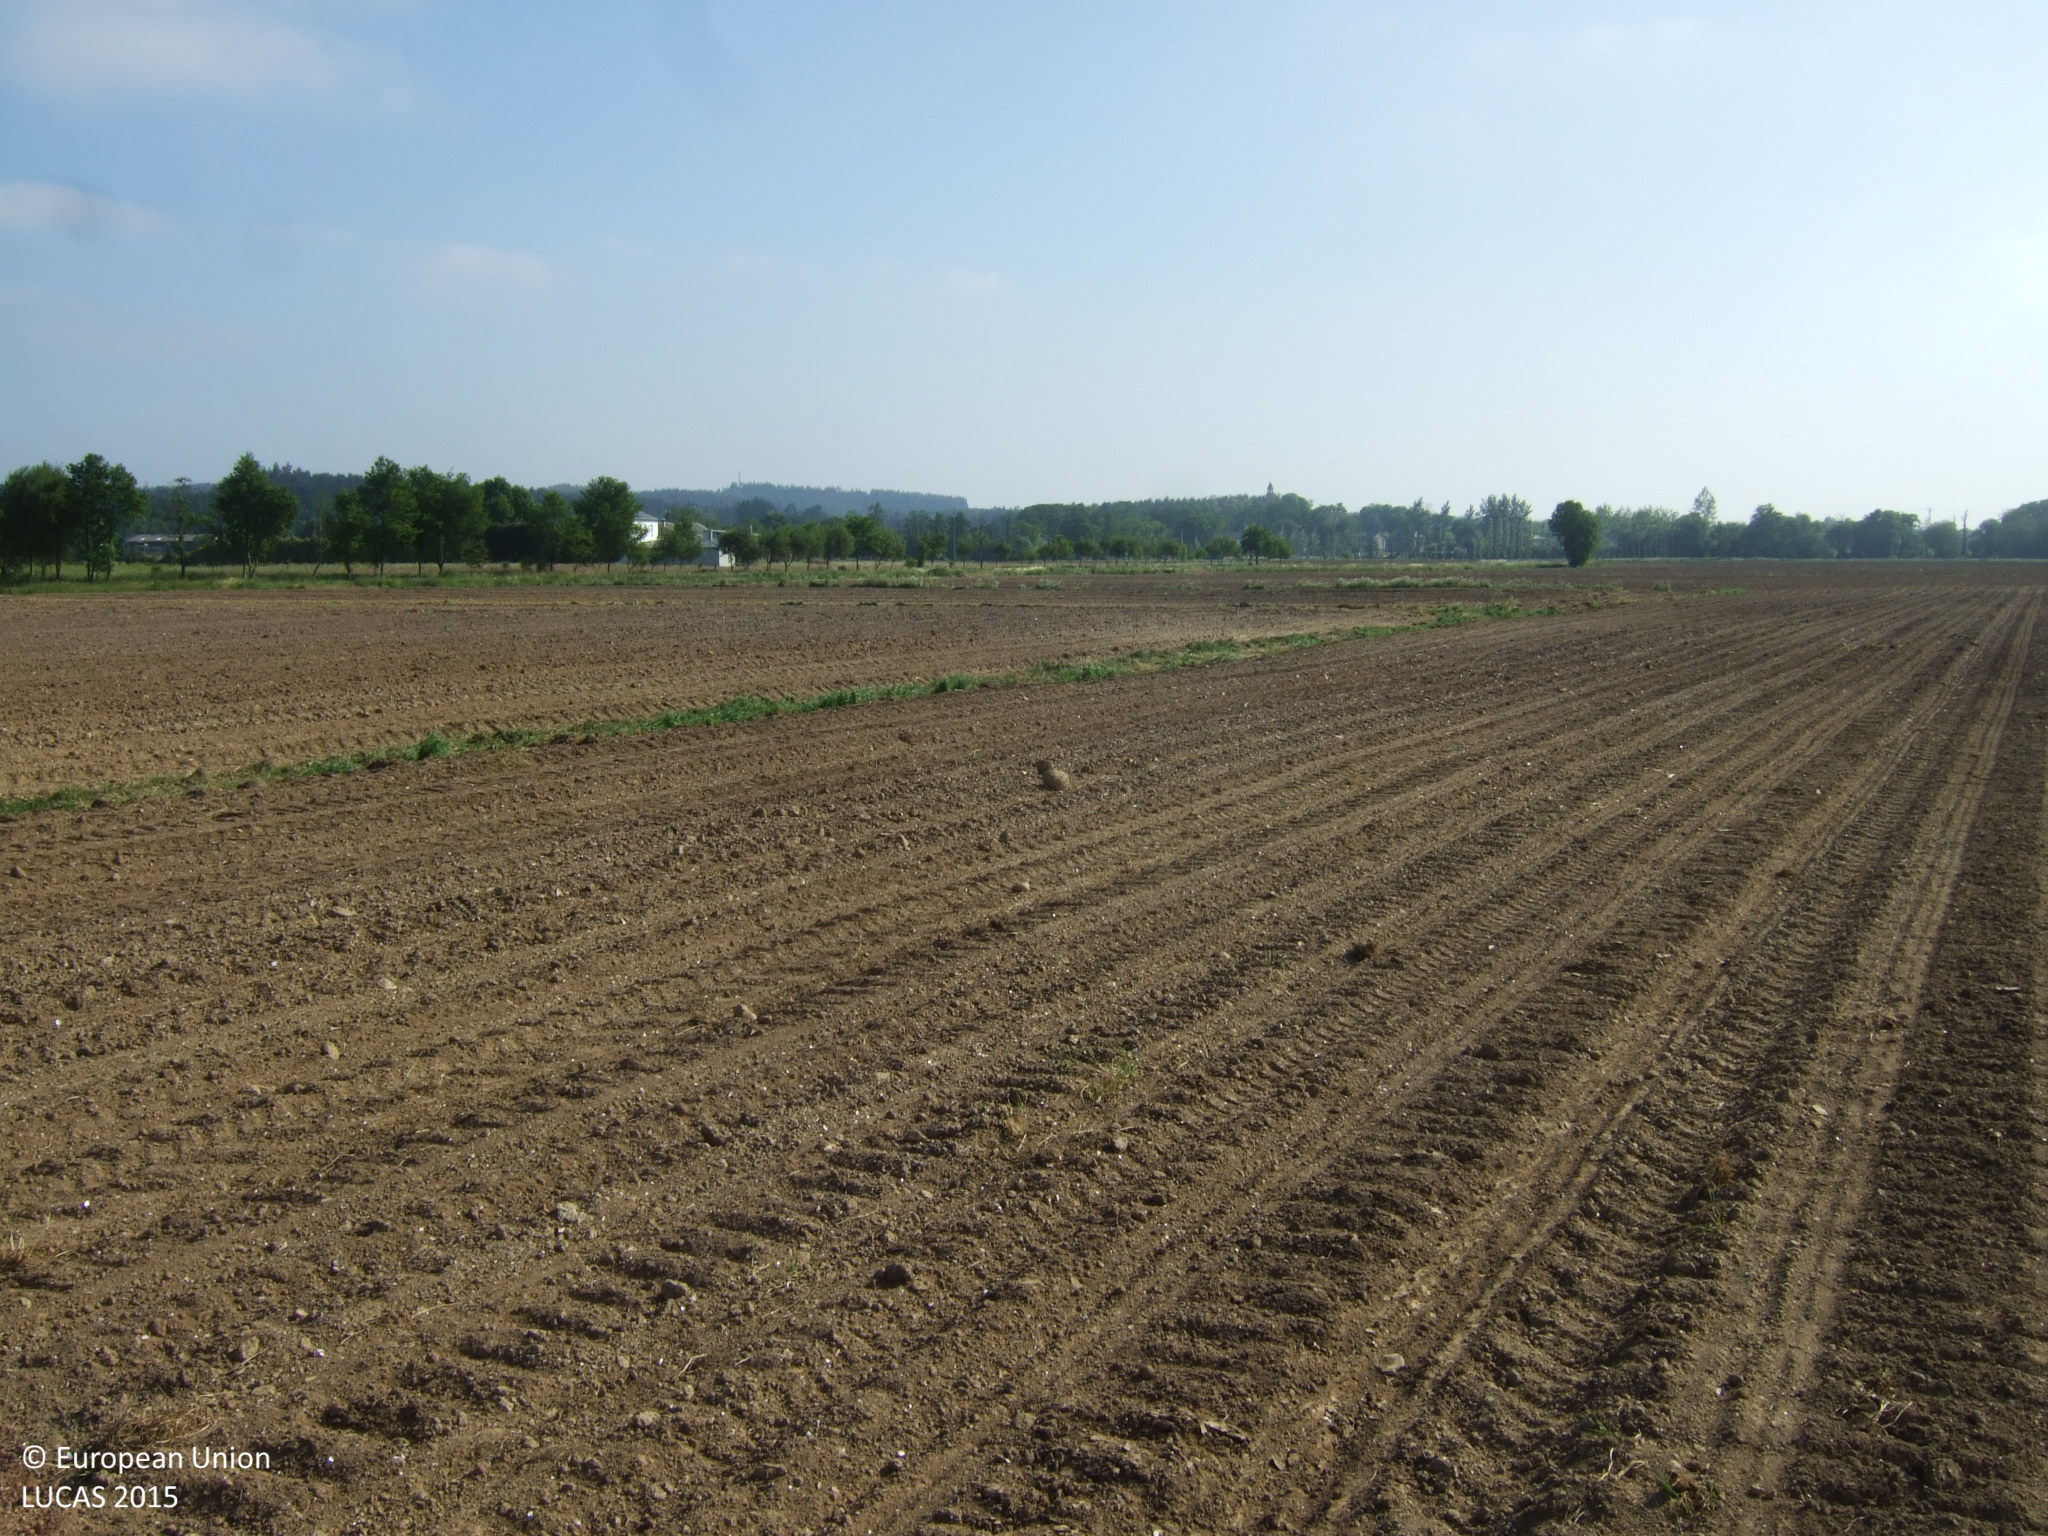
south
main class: Cropland
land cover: Maize
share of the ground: < 10 %
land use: Agriculture (excluding fallow land and kitchen gardens)
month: June
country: ES
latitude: 43.2523
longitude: -7.4064
